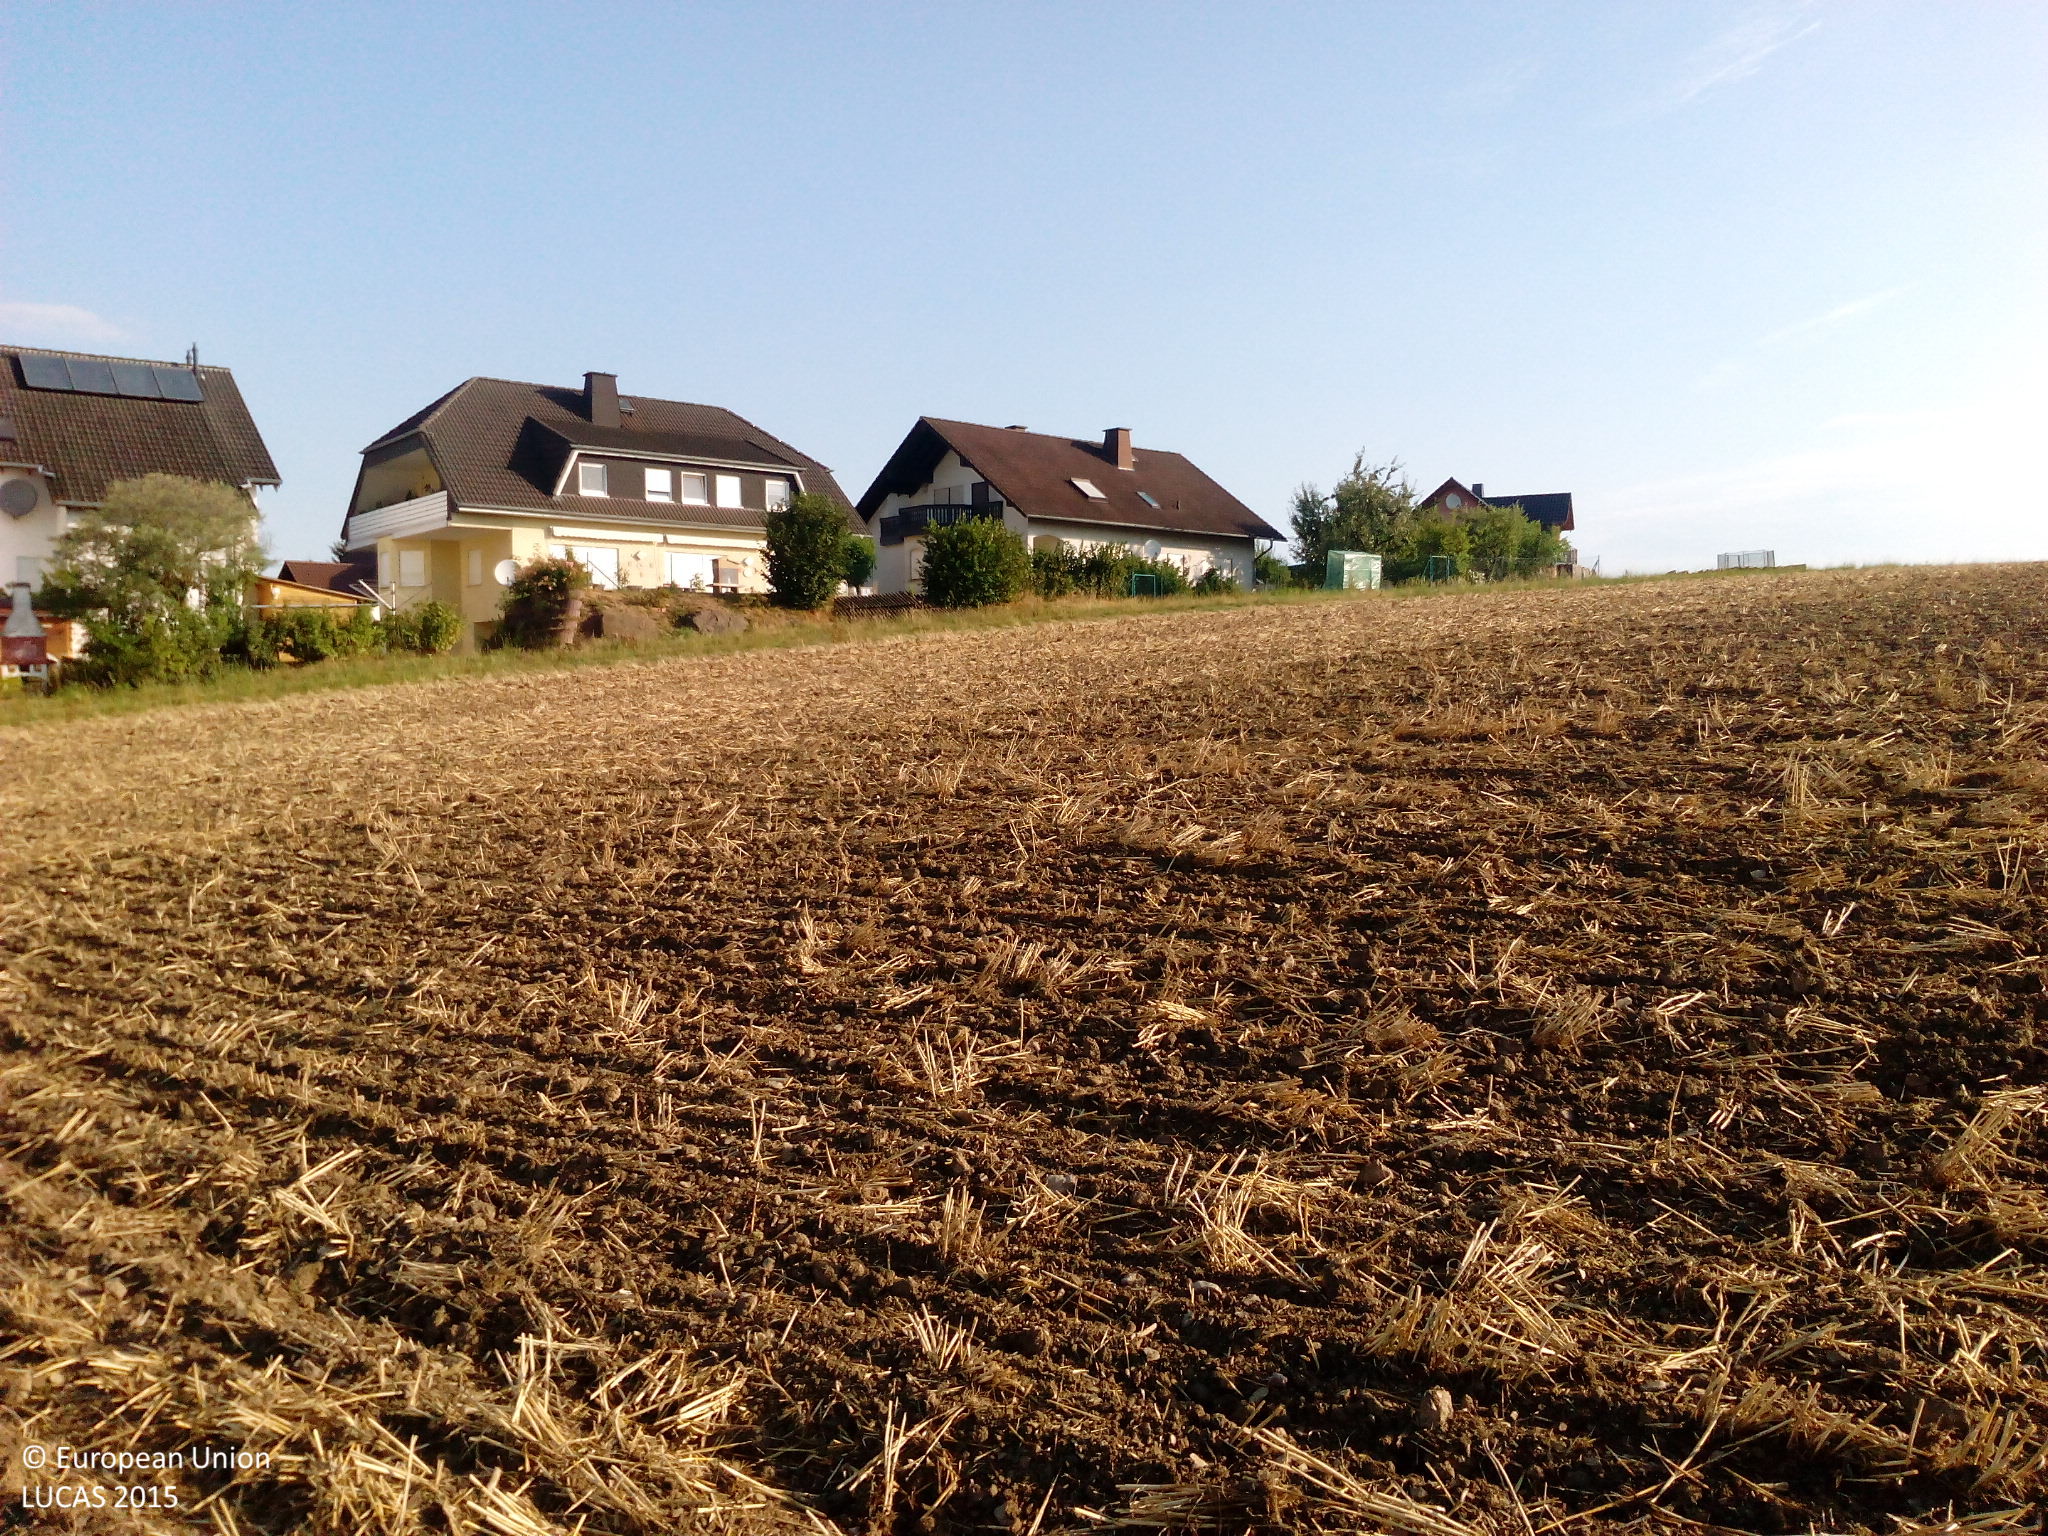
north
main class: Cropland
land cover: Common wheat
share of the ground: < 10 %
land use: Agriculture (excluding fallow land and kitchen gardens)
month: August
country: DE
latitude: 50.2391
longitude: 8.0234
